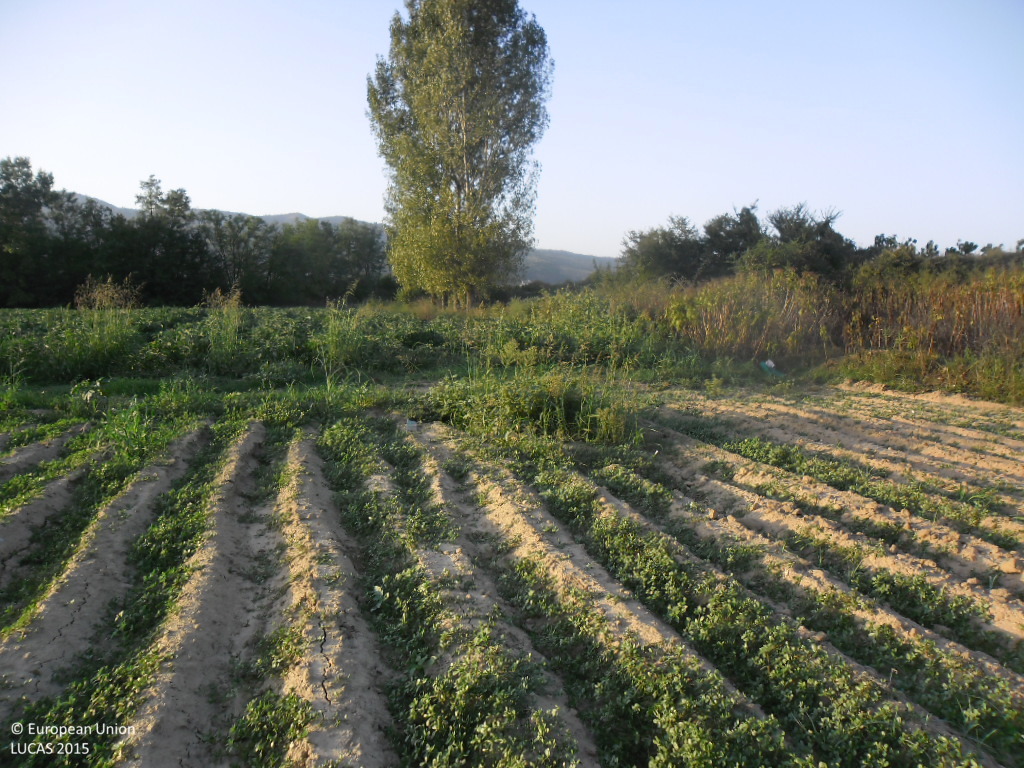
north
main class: Cropland
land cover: Potatoes
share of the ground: < 10 %
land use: Agriculture (excluding fallow land and kitchen gardens)
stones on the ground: < 10 %
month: September
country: BG
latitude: 41.4245
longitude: 23.1690
